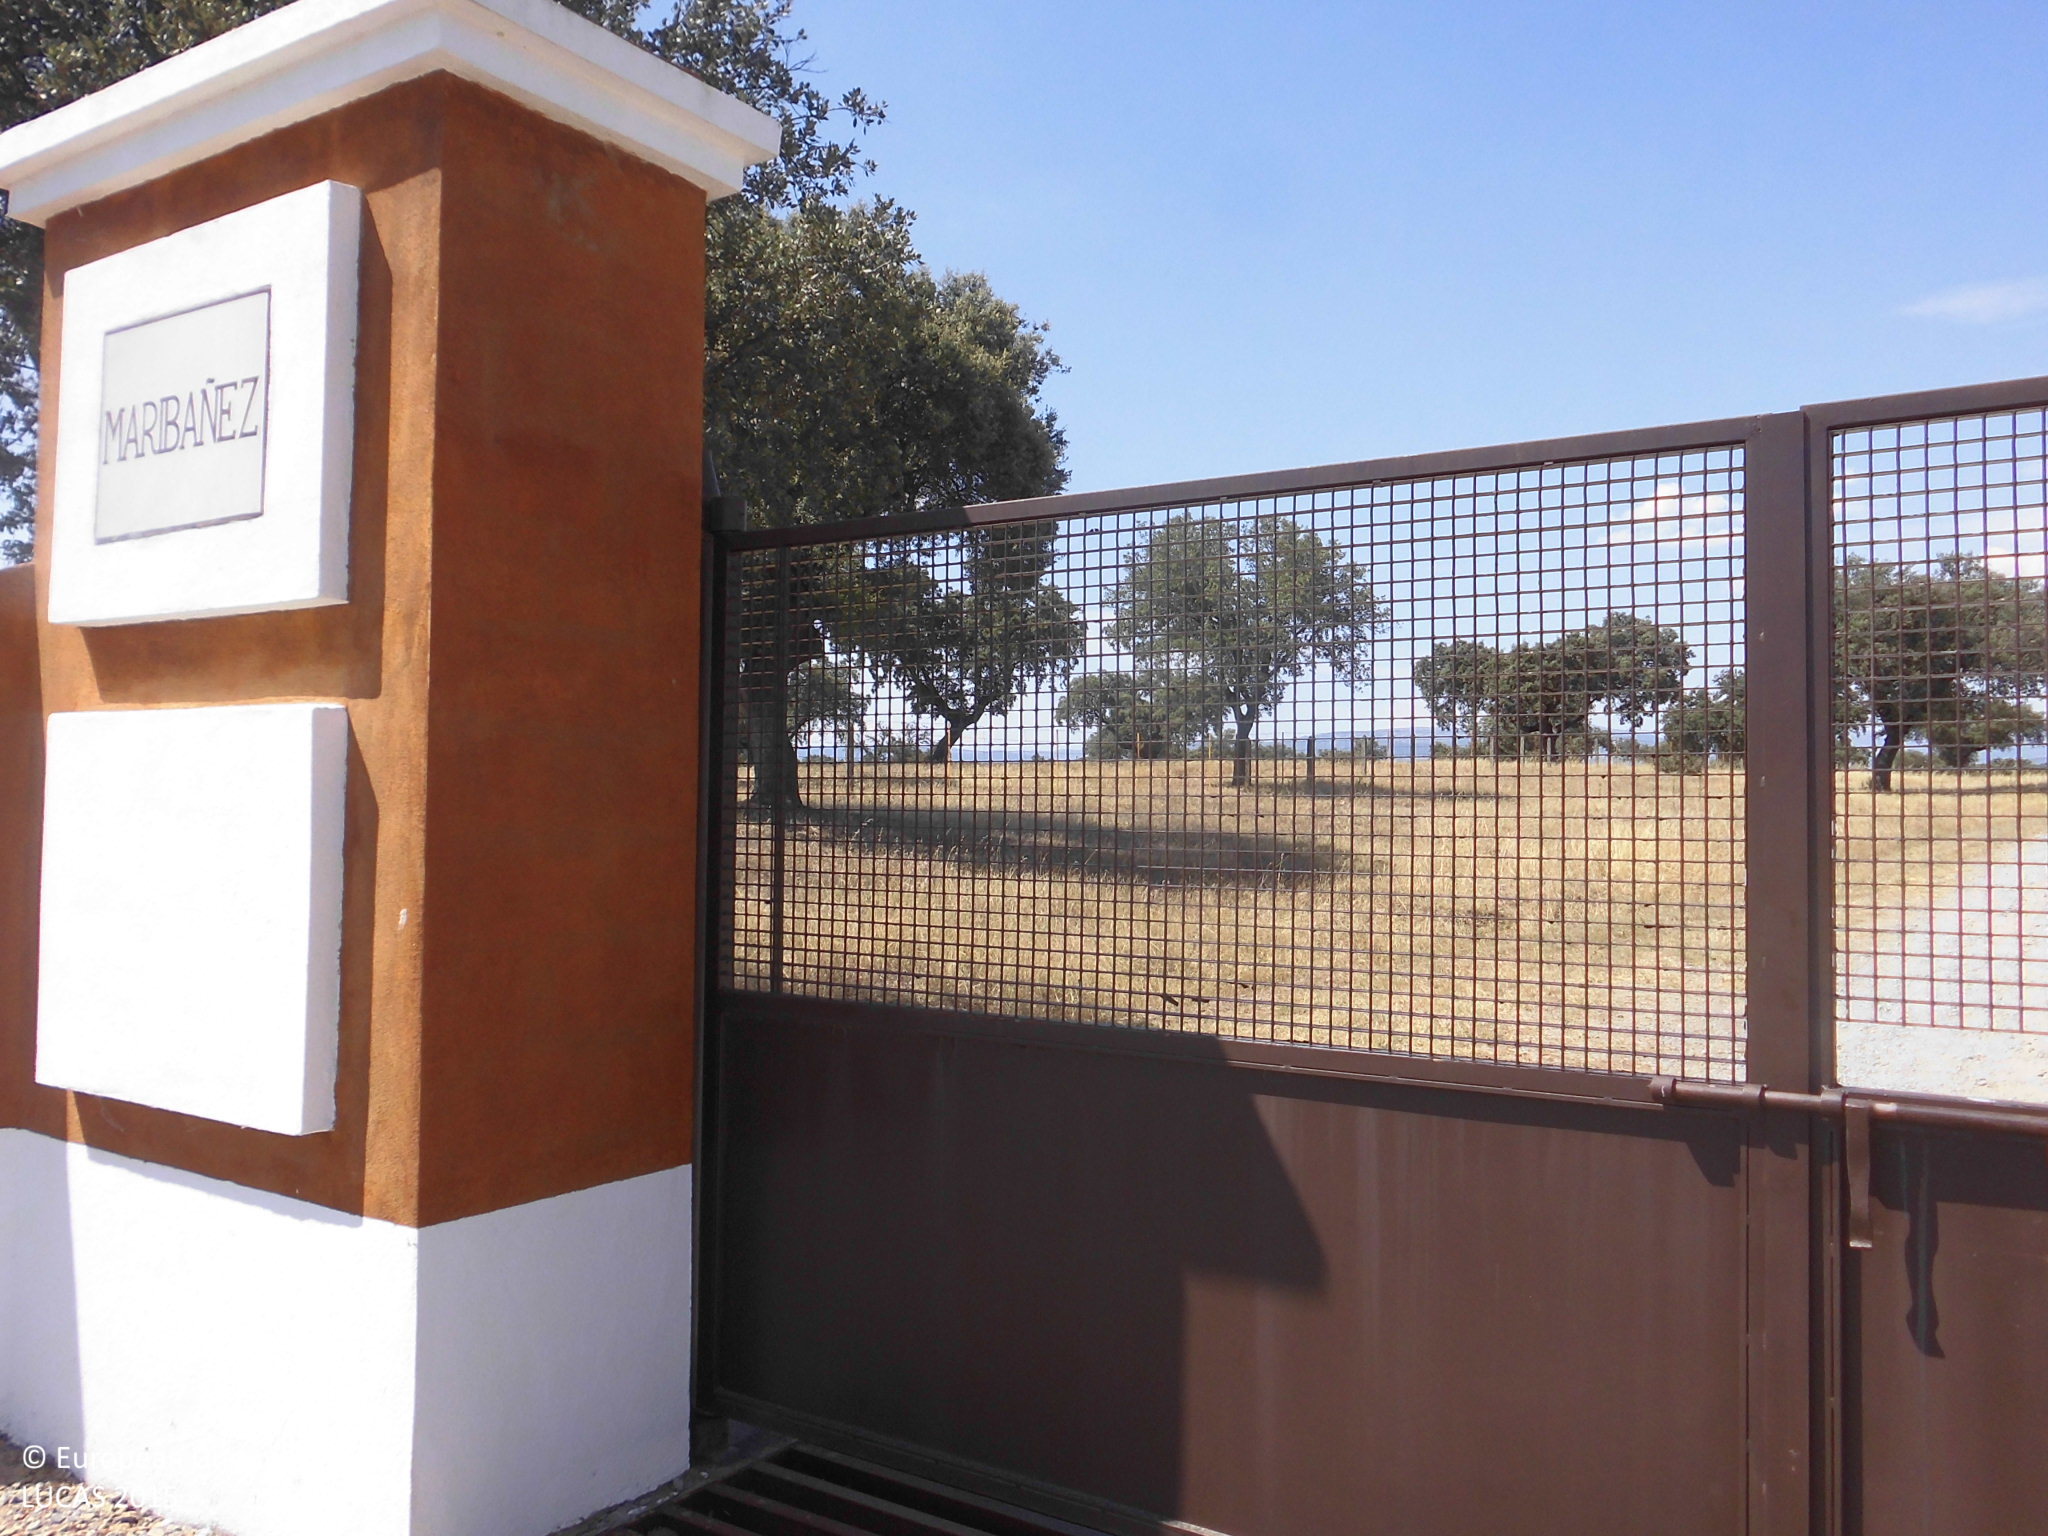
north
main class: Woodland
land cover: Broadleaved woodland
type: broadleaved evergreen forest
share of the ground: 10 - 25 %
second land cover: Grassland without tree/shrub cover
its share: > 75 %
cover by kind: herbaceous plants 90 %, broadleaved forest trees 10 %
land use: Forestry
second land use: Agriculture (excluding fallow land and kitchen gardens)
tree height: > 5 m
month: July
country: ES
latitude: 39.9338
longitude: -5.8036
